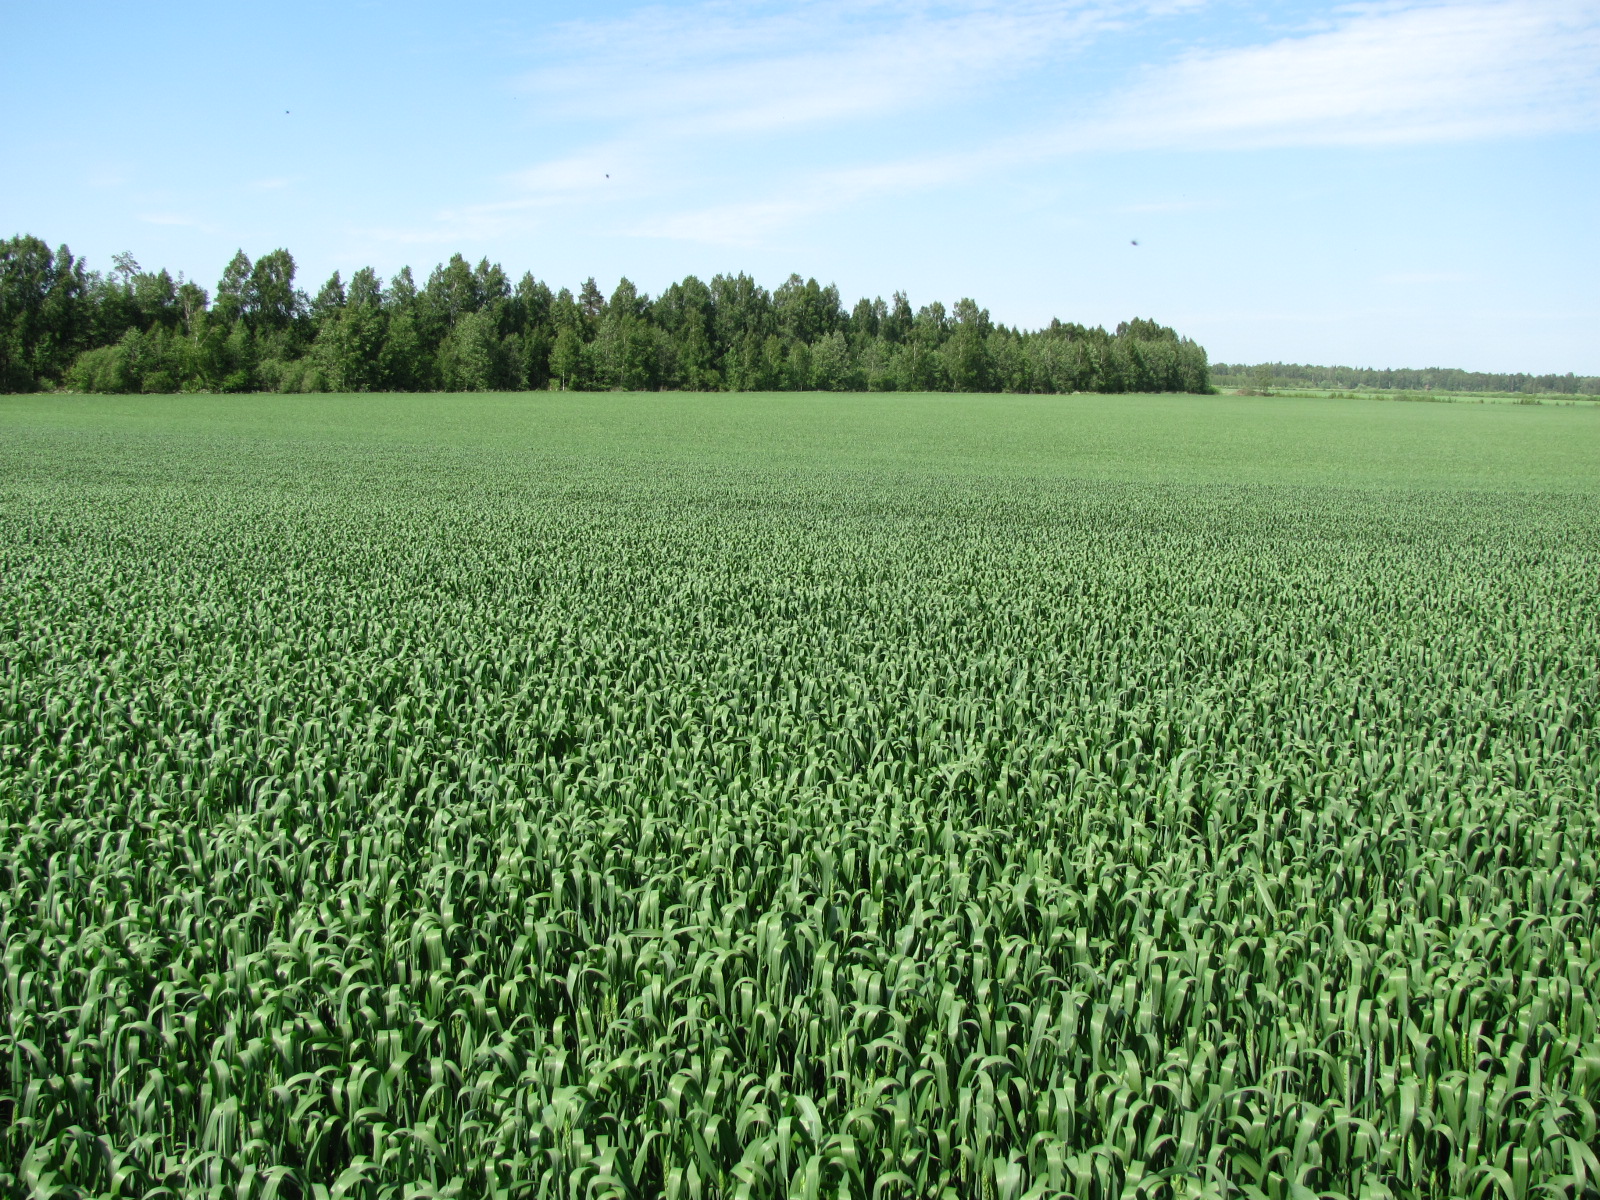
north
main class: Cropland
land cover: Common wheat
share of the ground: > 75 %
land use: Agriculture (excluding fallow land and kitchen gardens)
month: June
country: LV
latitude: 56.4790
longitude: 24.2984
